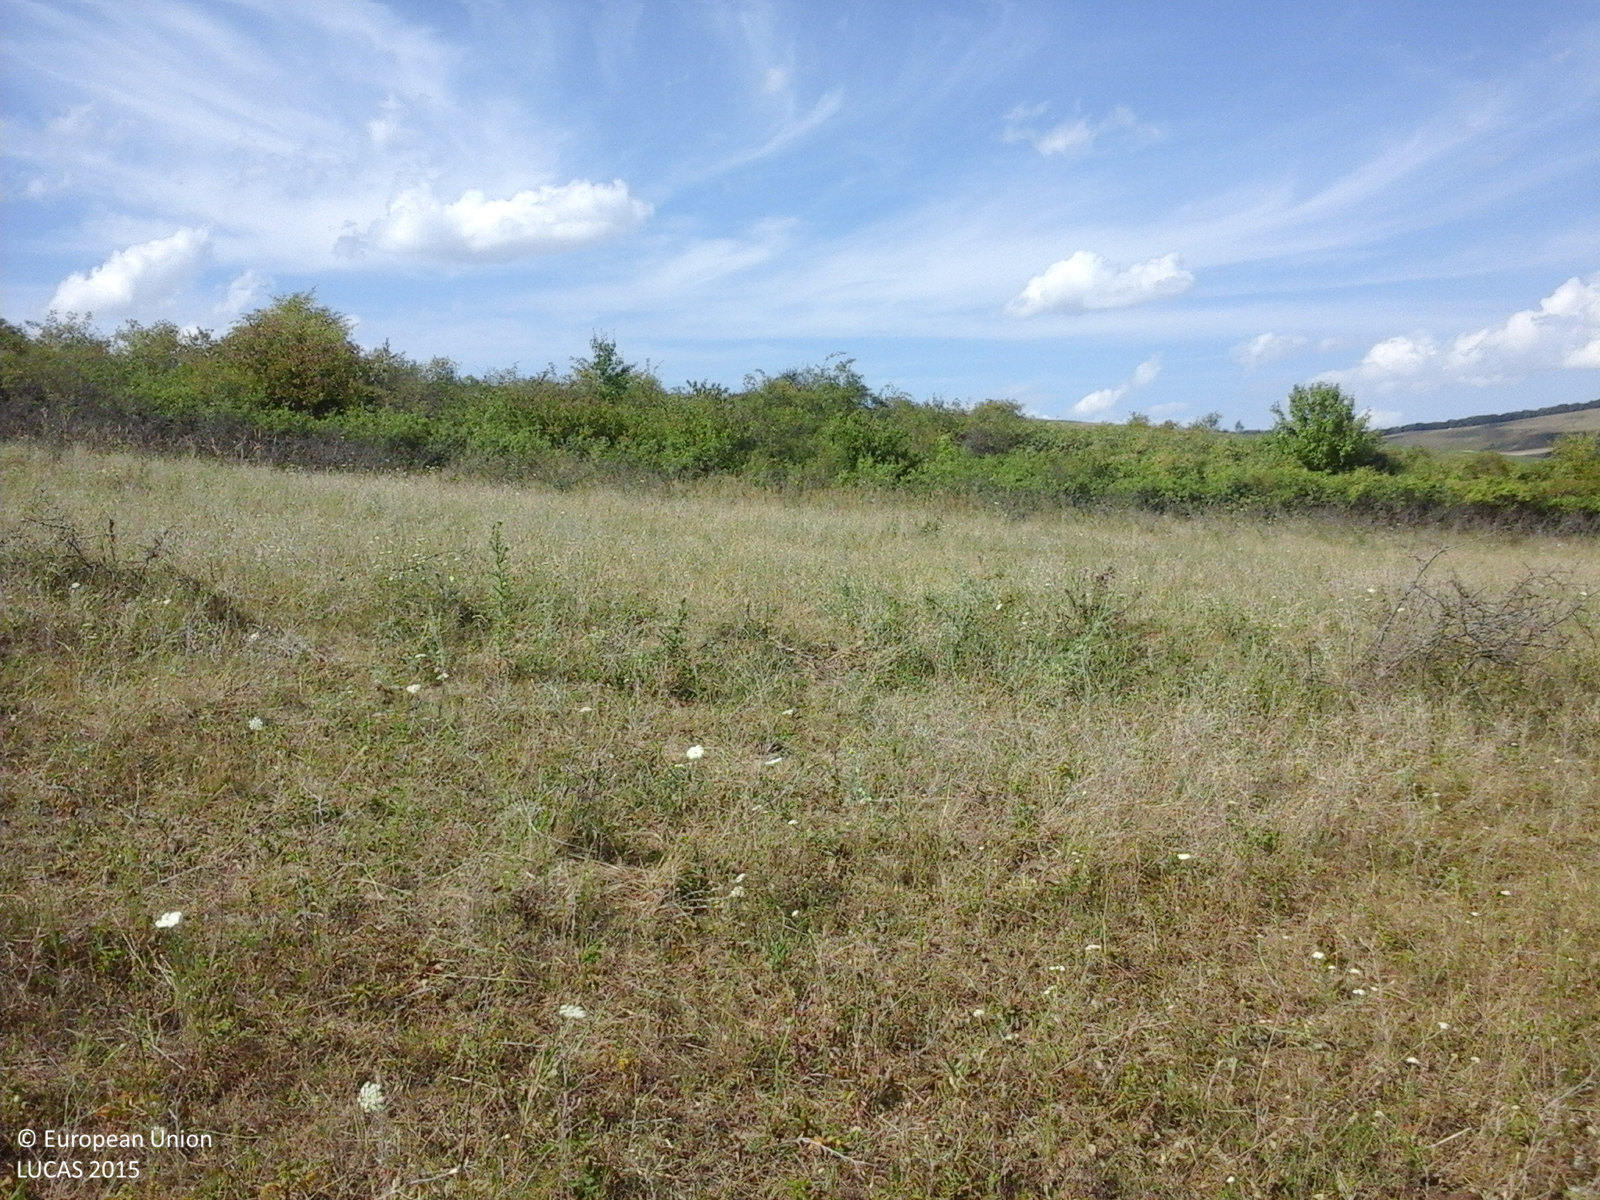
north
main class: Grassland
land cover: Grassland without tree/shrub cover
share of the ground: > 75 %
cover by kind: herbaceous plants 100 %
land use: Agriculture (excluding fallow land and kitchen gardens)
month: July
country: RO
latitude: 46.6076
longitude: 27.3810
